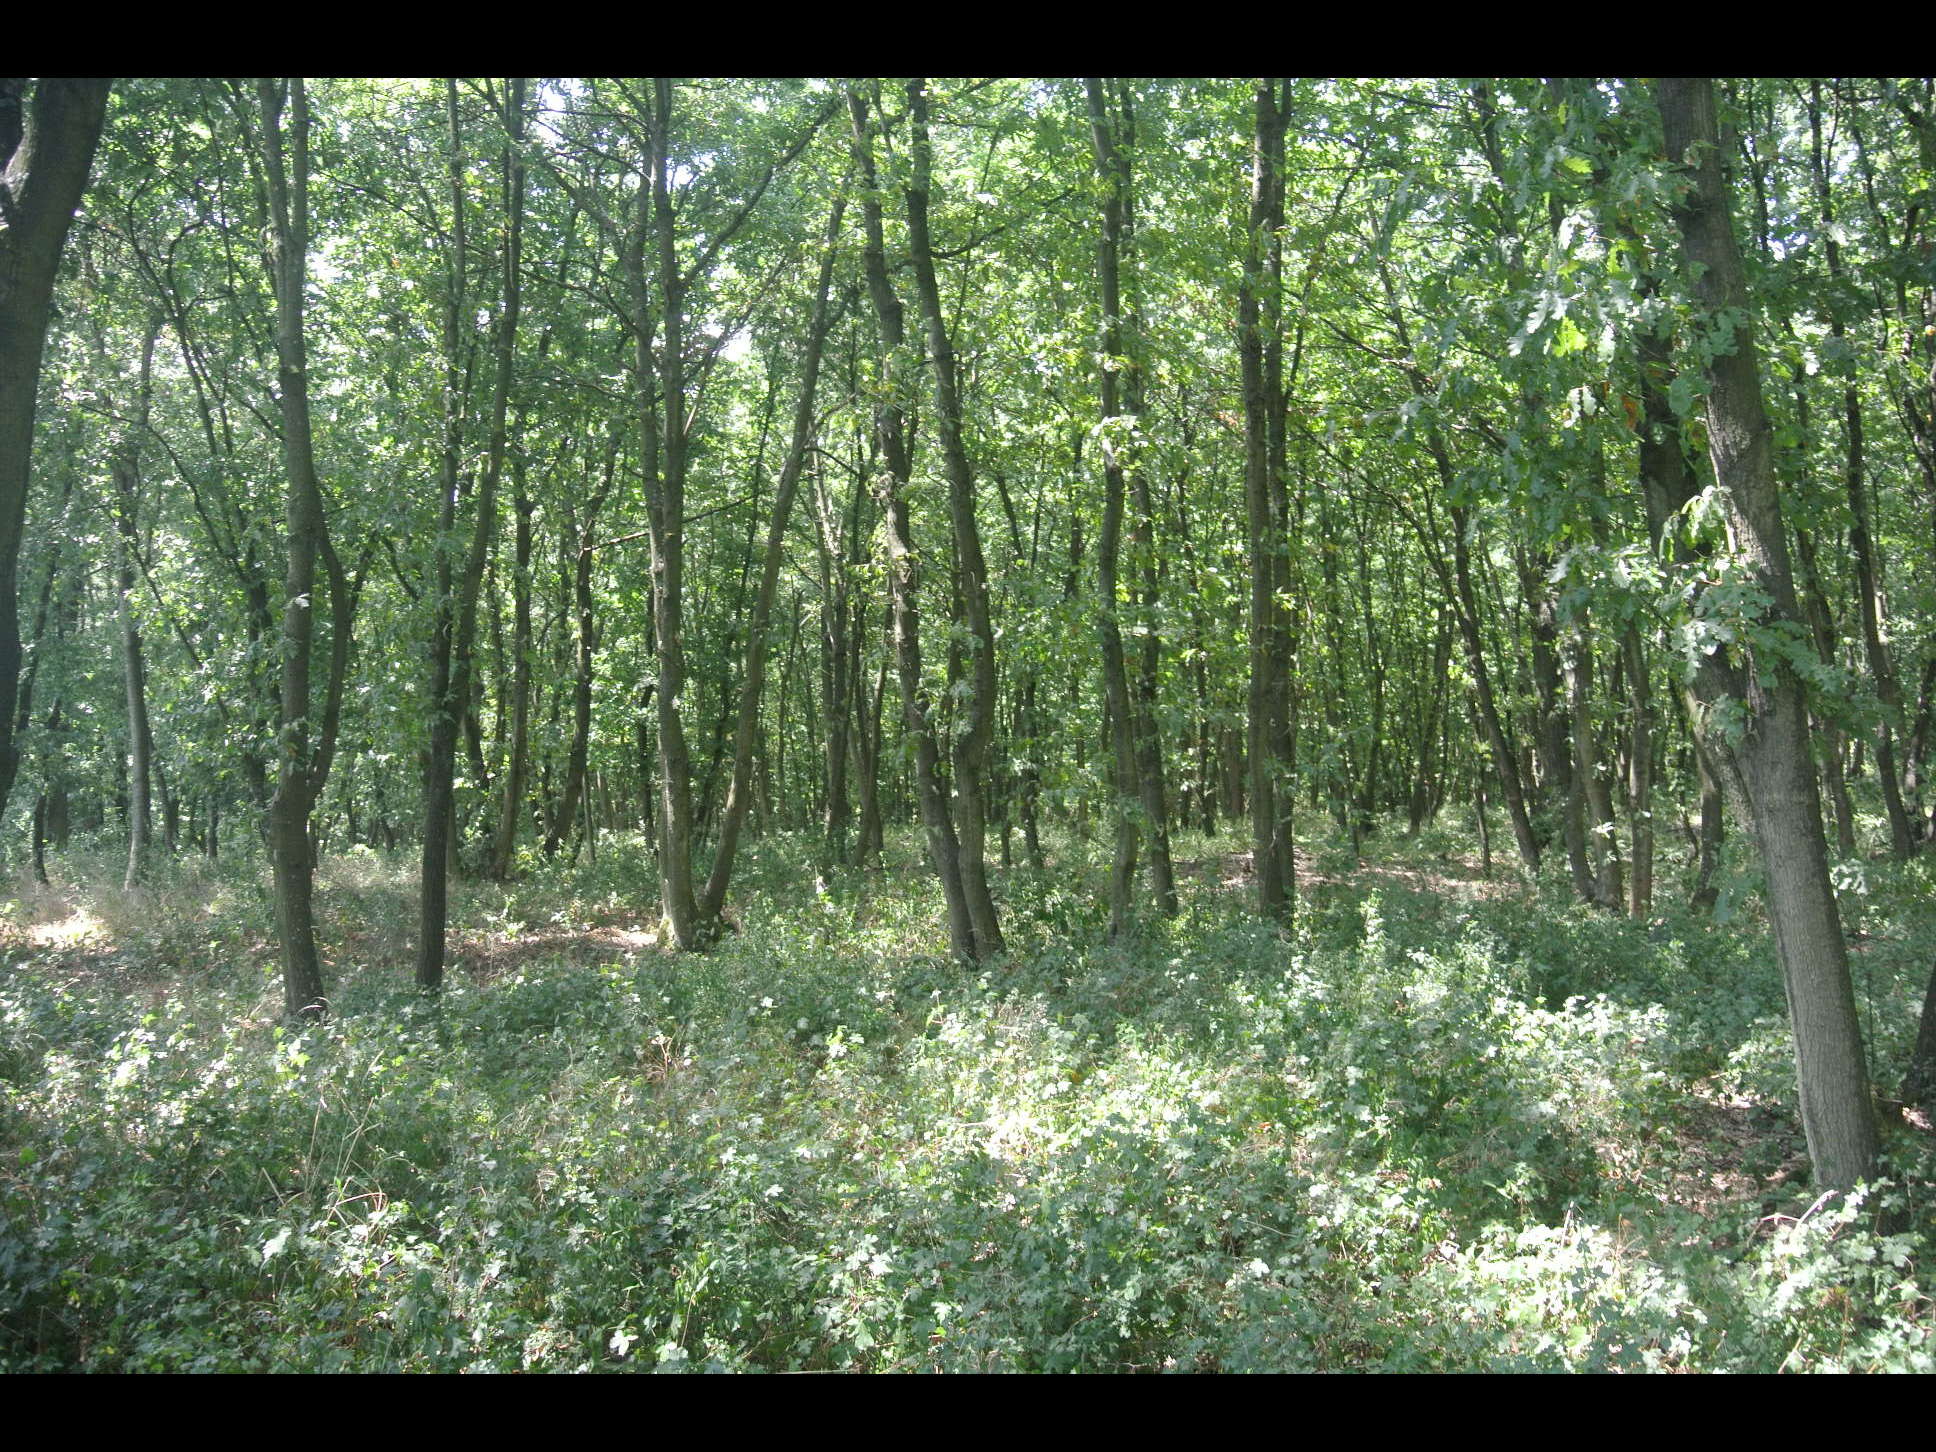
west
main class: Woodland
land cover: Broadleaved woodland
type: beech forest
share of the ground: > 75 %
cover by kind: broadleaved forest trees 100 %
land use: Forestry
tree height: > 5 m
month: July
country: AT
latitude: 47.5736
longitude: 16.6114
